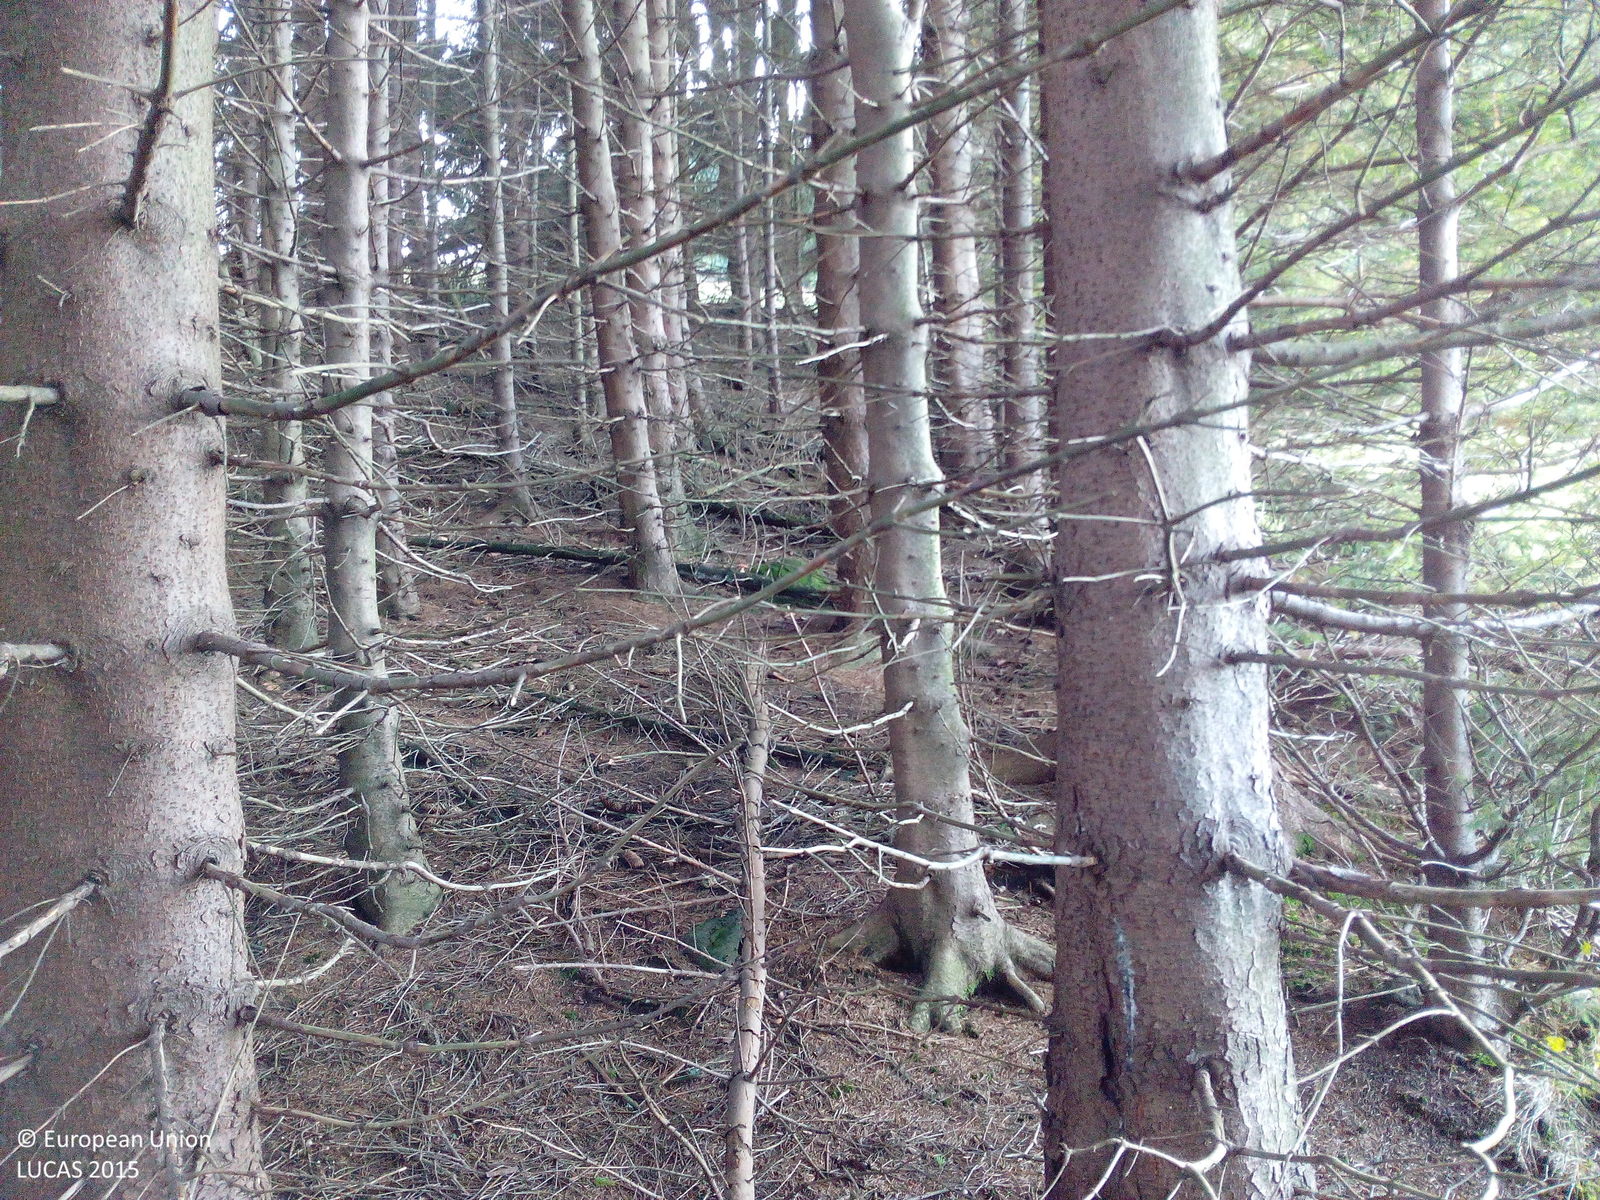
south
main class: Woodland
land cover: Spruce dominated coniferous woodland
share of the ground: > 75 %
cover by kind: coniferous forest trees 80 %, consolidated bare surface 15 %, lichens and mosses 5 %
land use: Forestry
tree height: > 5 m
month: October
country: DE
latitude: 50.4000
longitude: 9.9578
